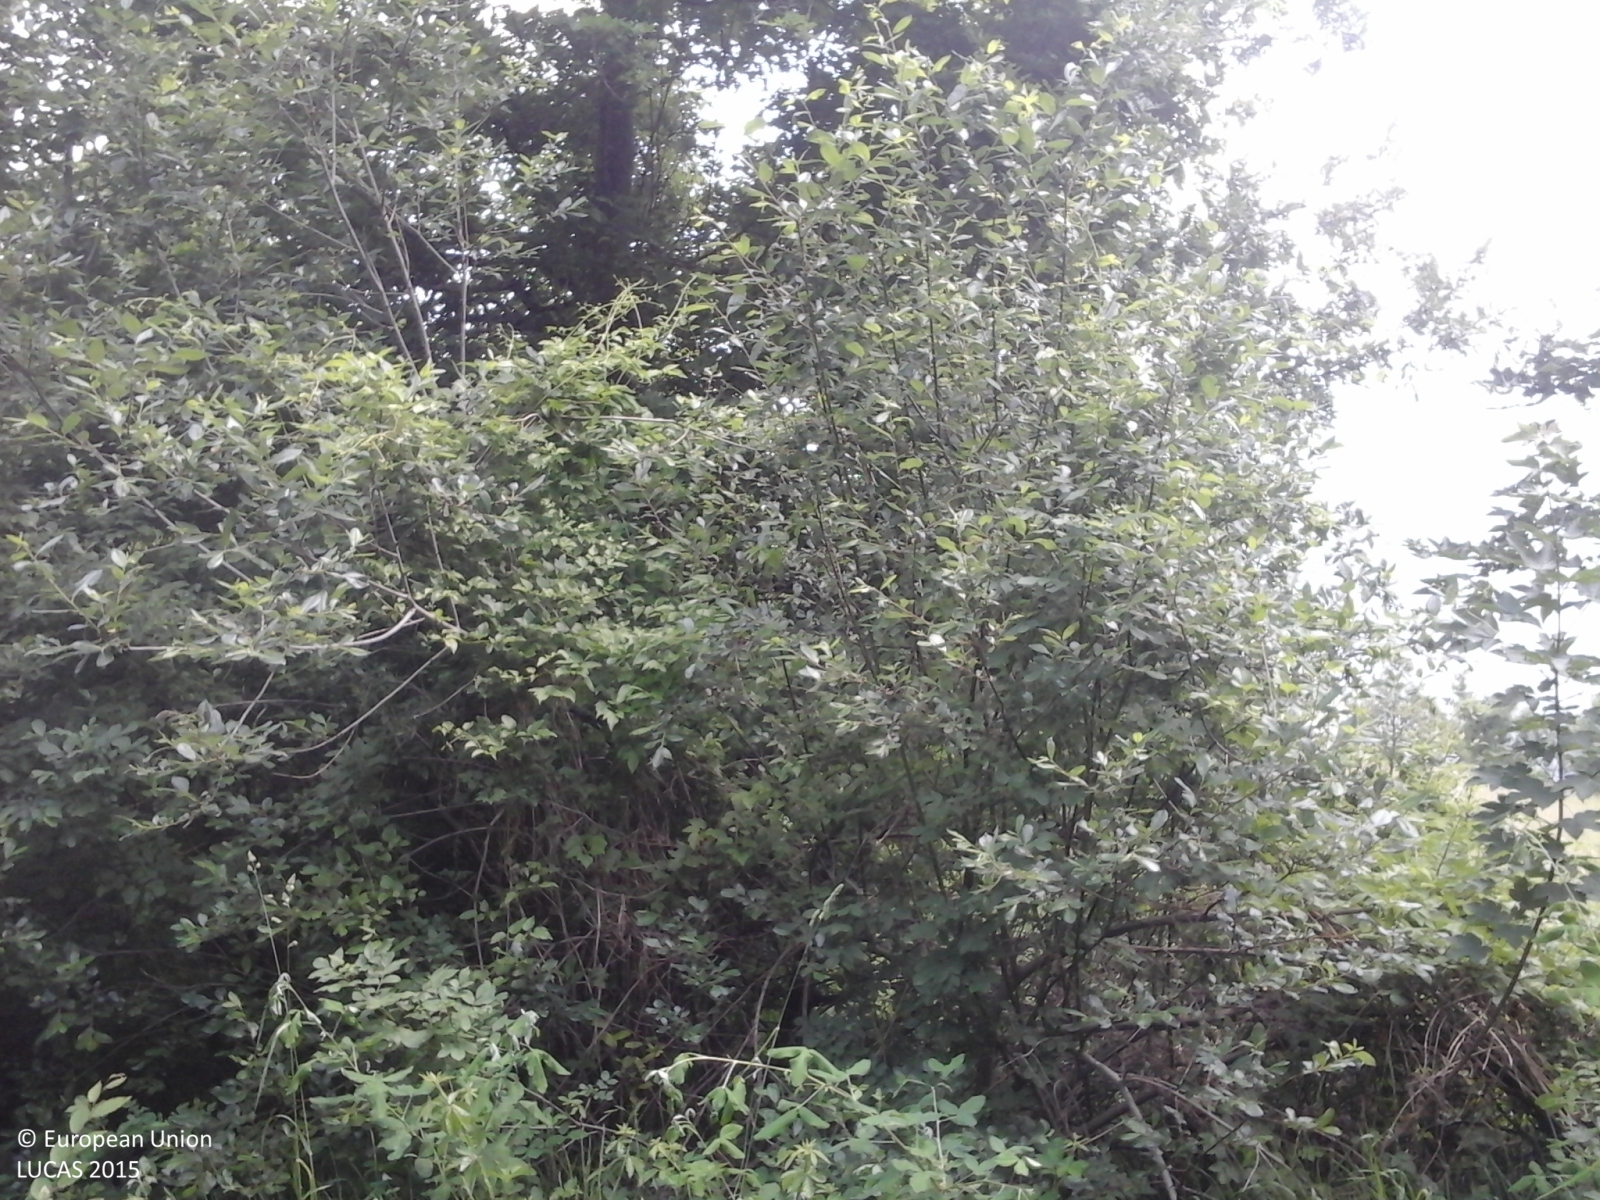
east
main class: Woodland
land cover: Broadleaved woodland
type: thermophilous deciduous forest
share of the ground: > 75 %
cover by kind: broadleaved forest trees 60 %, shrubs 20 %, consolidated bare surface 15 %, herbaceous plants 5 %
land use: Forestry
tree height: > 5 m
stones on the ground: > 50 %
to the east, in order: Broadleaved woodland; Tracks; Broadleaved woodland; Grassland without tree/shrub cover; Electric lines; Grassland without tree/shrub cover; Shrubland without tree cover; Broadleaved woodland
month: June
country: IT
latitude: 44.2582
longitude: 10.6623
